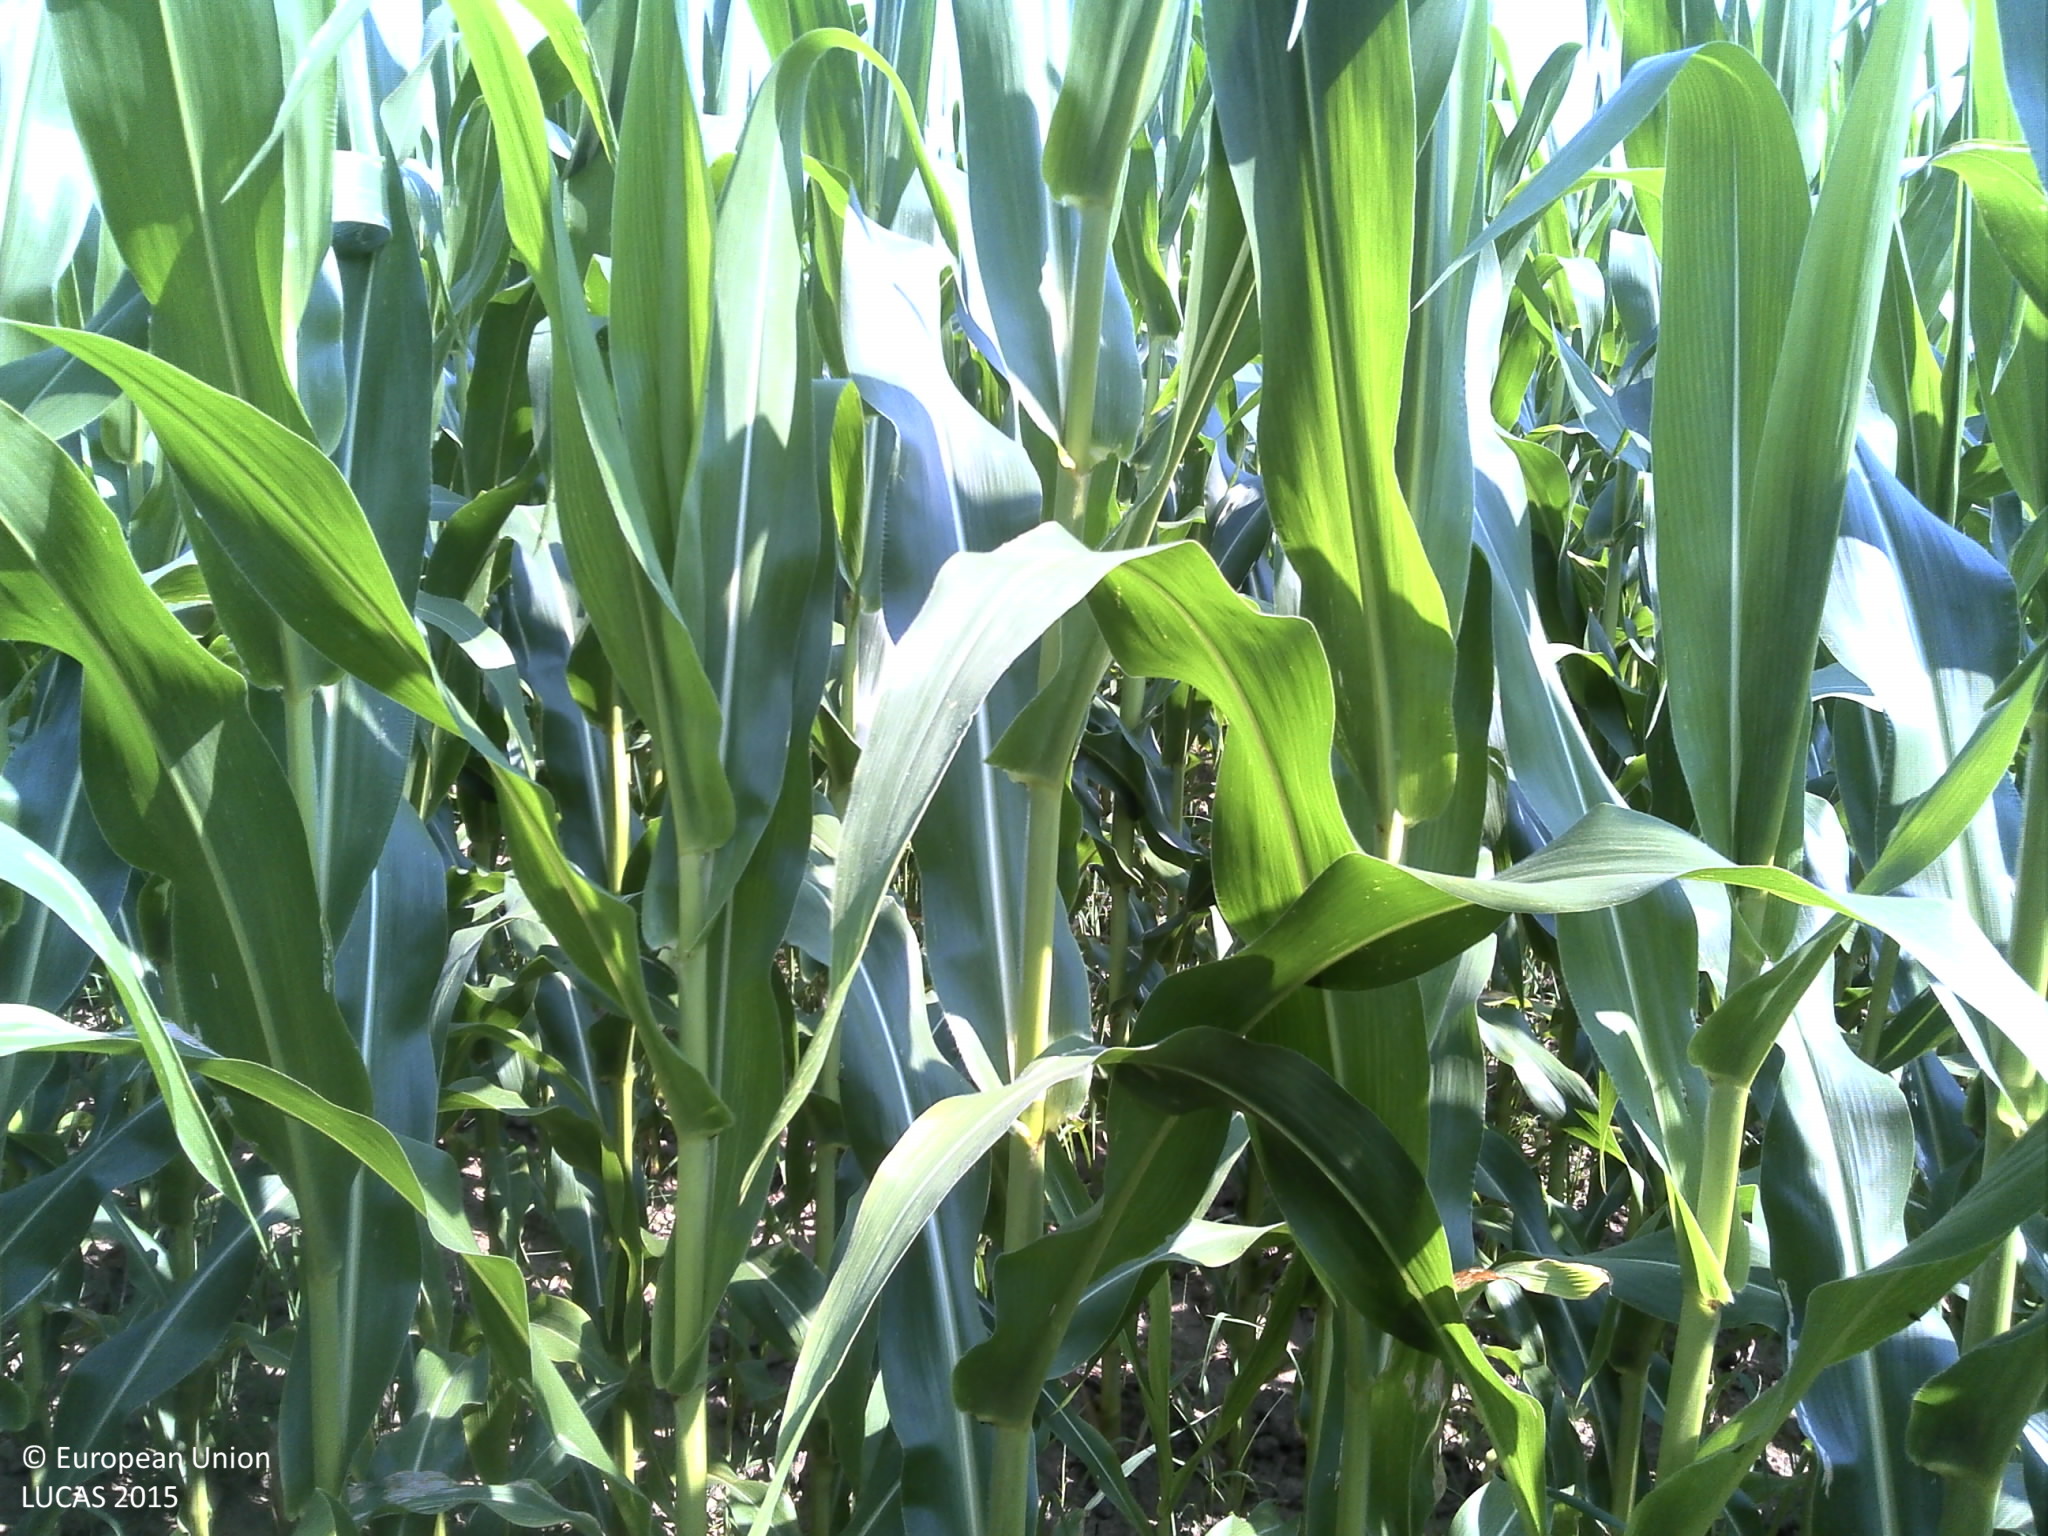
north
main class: Cropland
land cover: Maize
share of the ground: > 75 %
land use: Agriculture (excluding fallow land and kitchen gardens)
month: July
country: HR
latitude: 45.9410
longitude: 16.7204
